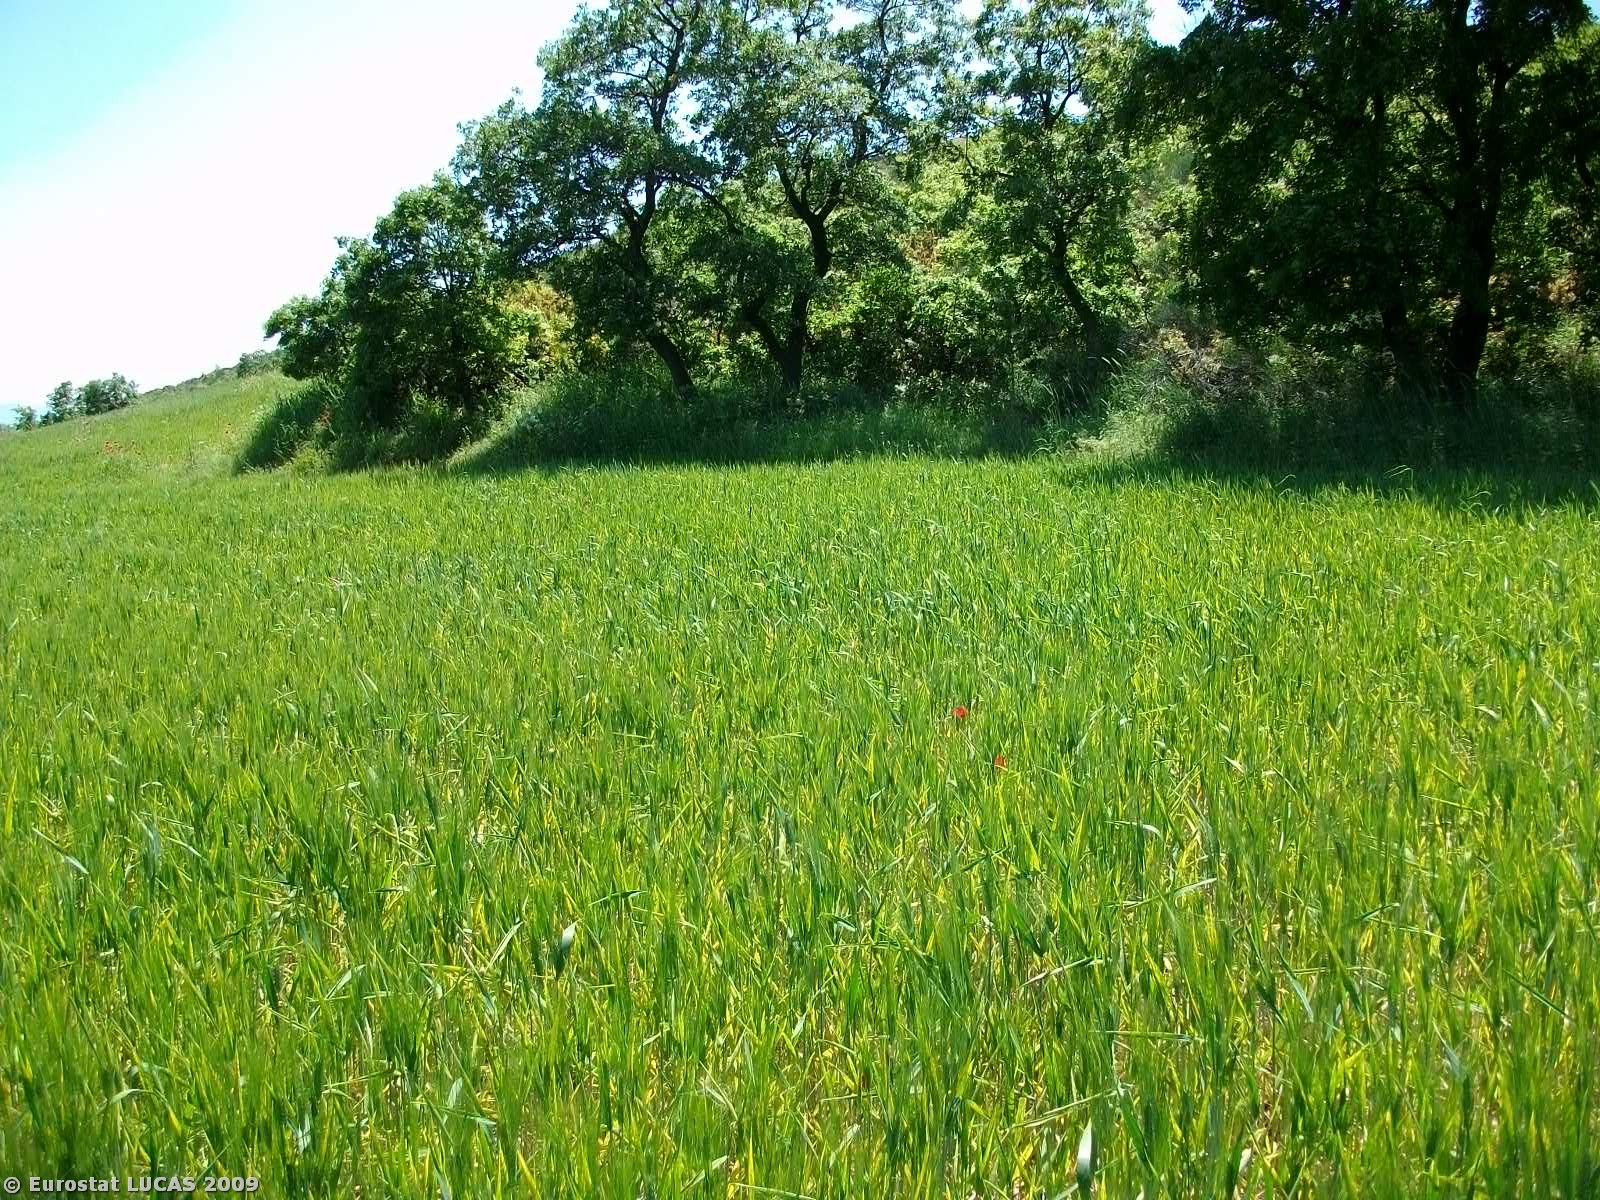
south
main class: Cropland
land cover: Durum wheat
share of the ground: > 75 %
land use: Agriculture (excluding fallow land and kitchen gardens)
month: May
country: GR
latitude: 39.2138
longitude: 22.4583
